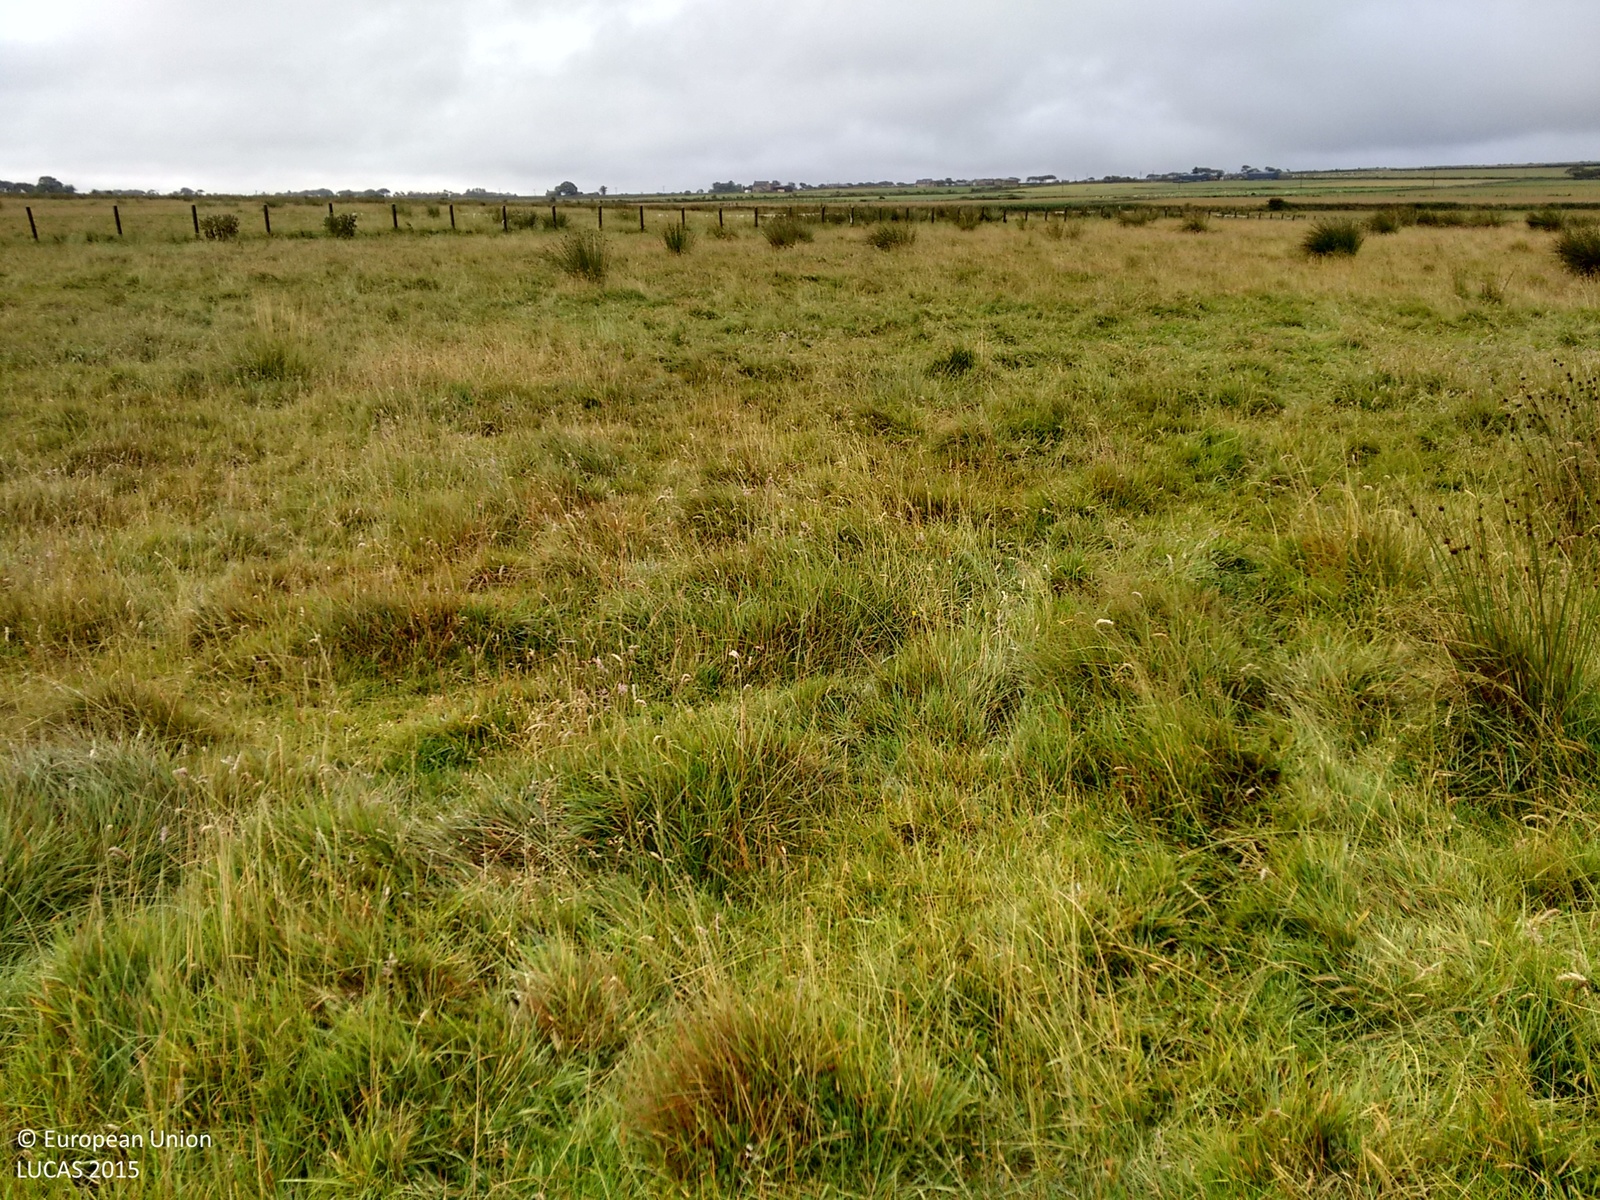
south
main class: Grassland
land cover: Grassland without tree/shrub cover
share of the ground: > 75 %
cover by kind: herbaceous plants 100 %
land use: Agriculture (excluding fallow land and kitchen gardens)
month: September
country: GB
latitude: 58.5130
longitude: -3.4003
